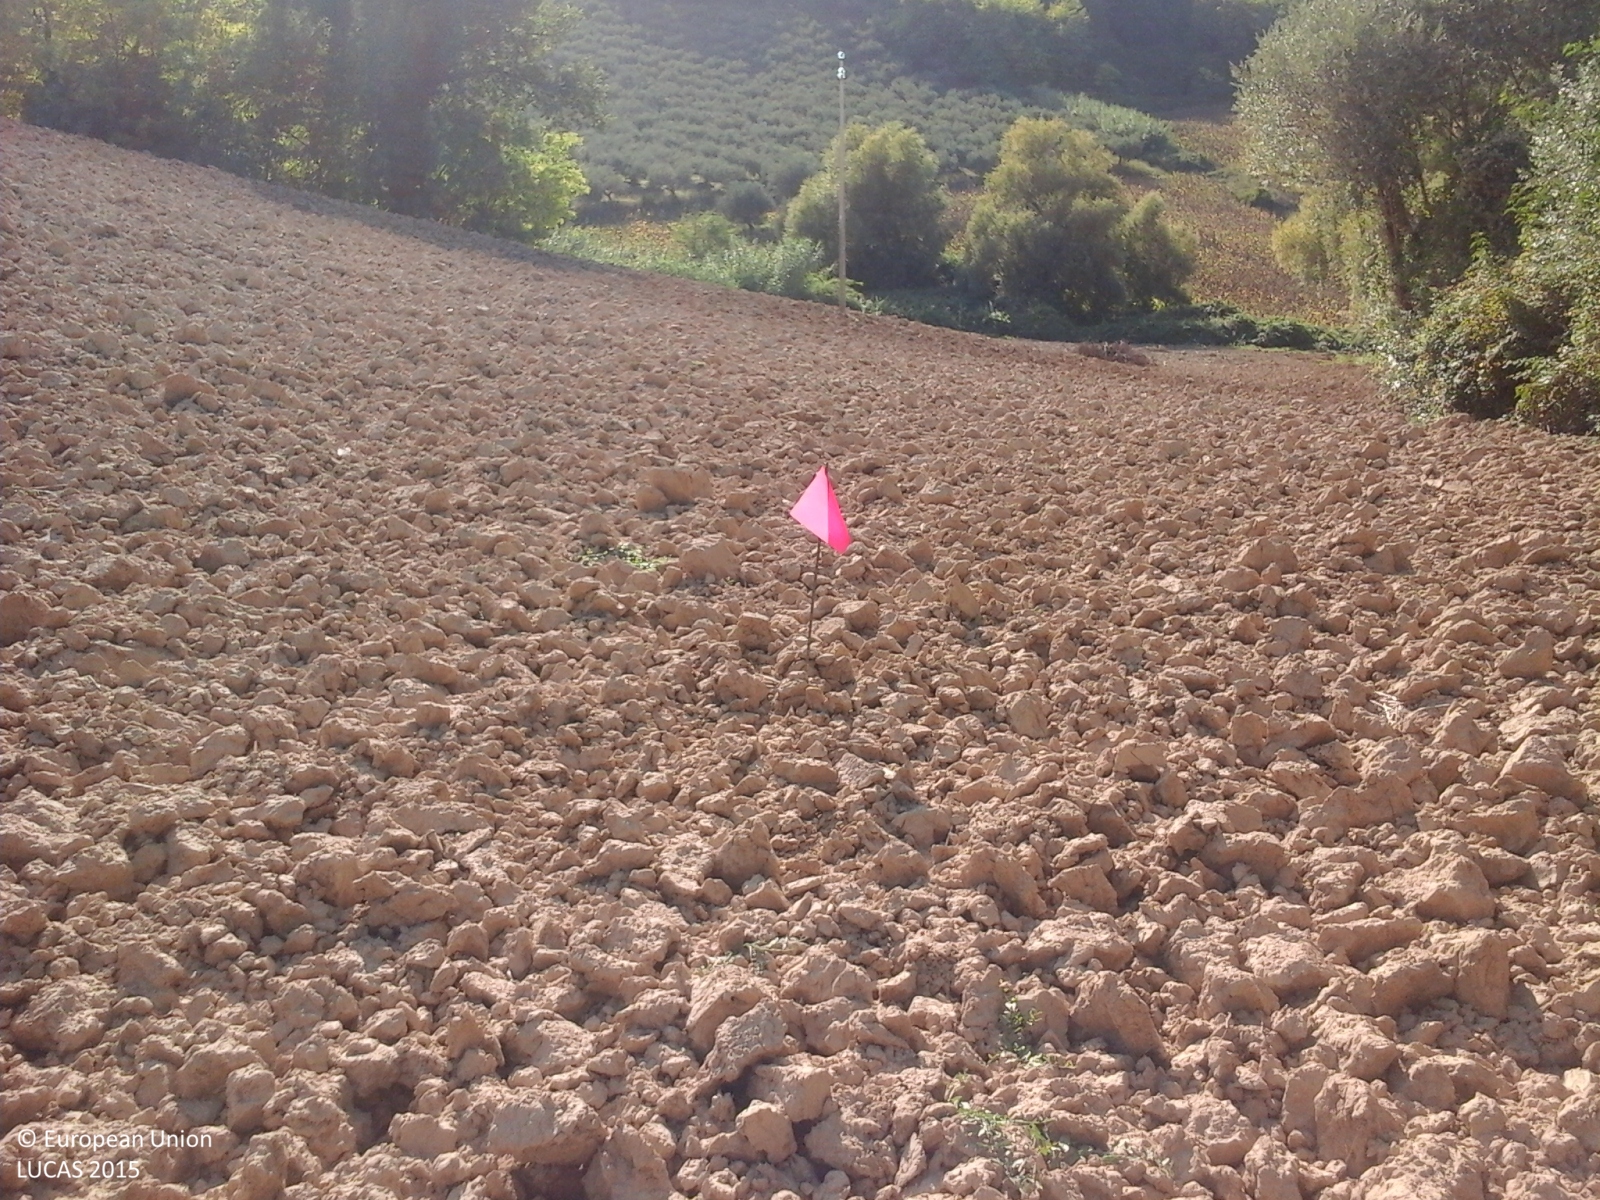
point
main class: Cropland
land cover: Durum wheat
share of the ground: < 10 %
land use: Agriculture (excluding fallow land and kitchen gardens)
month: September
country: IT
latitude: 43.7689
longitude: 12.8876
